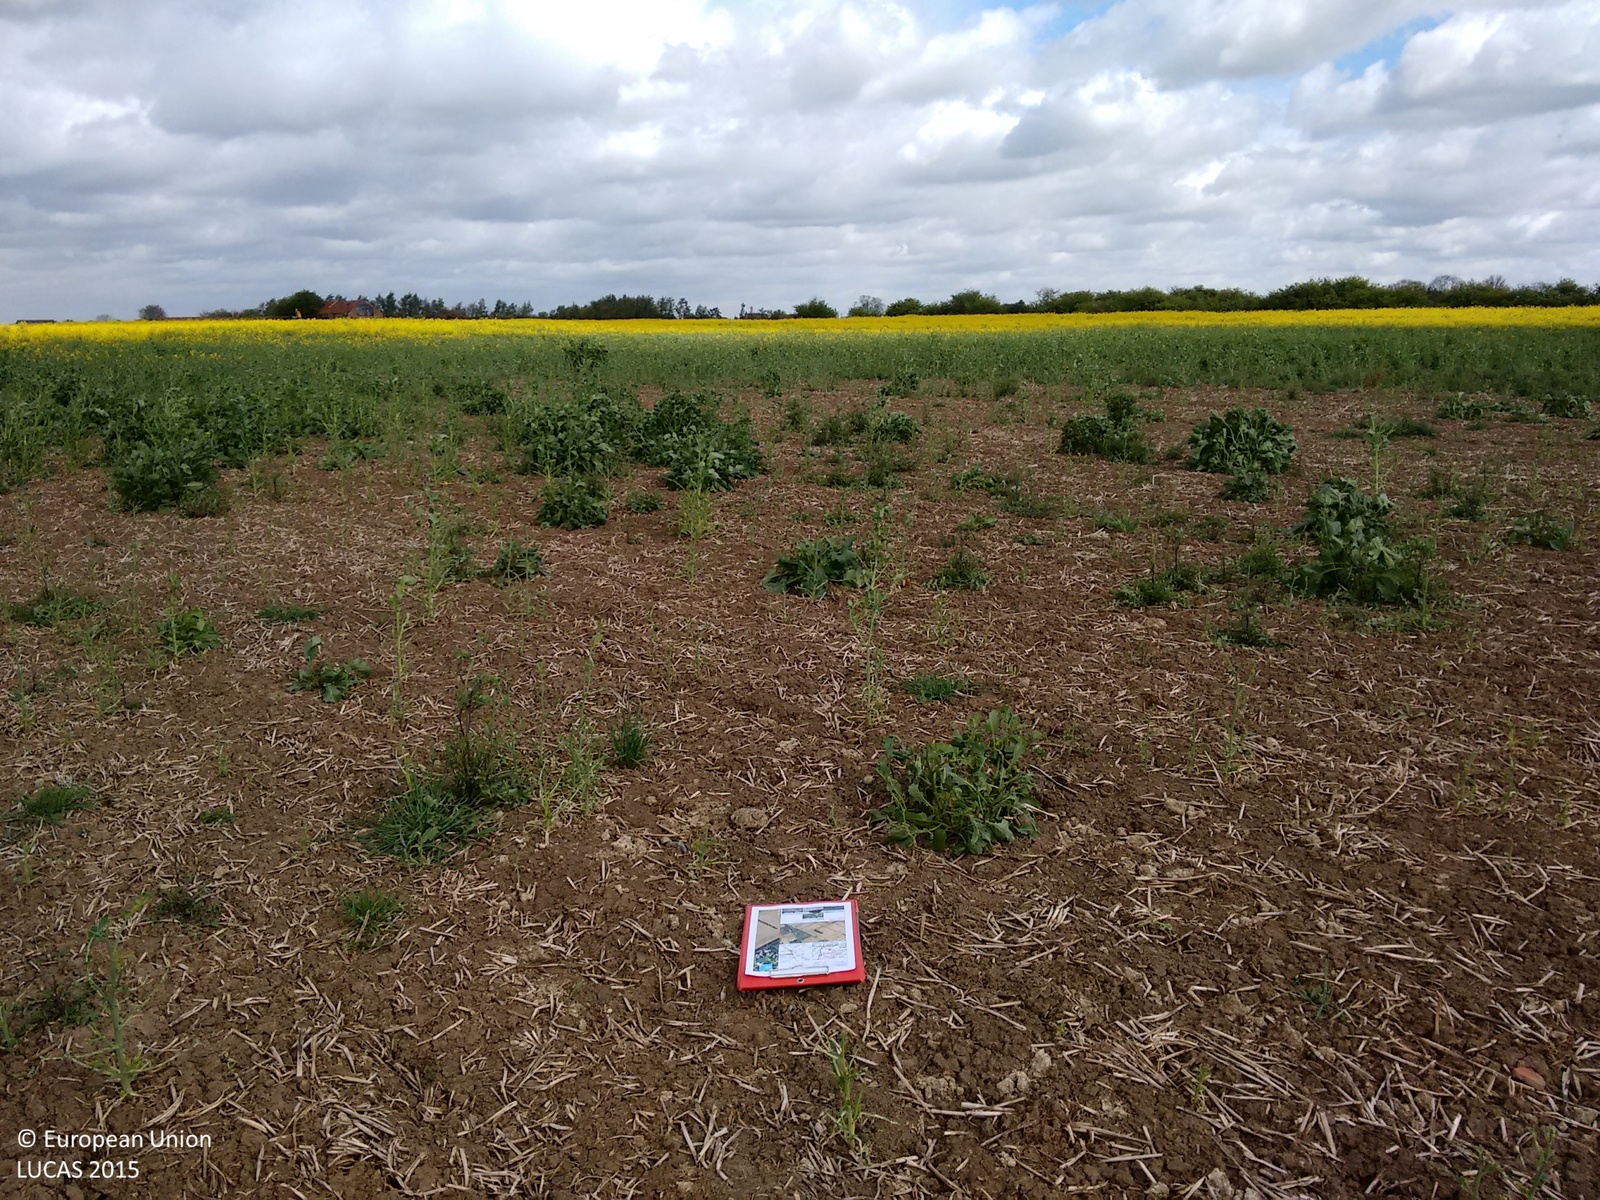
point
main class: Cropland
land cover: Rape and turnip rape
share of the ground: < 10 %
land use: Agriculture (excluding fallow land and kitchen gardens)
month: May
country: GB
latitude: 53.0331
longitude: -0.0988
